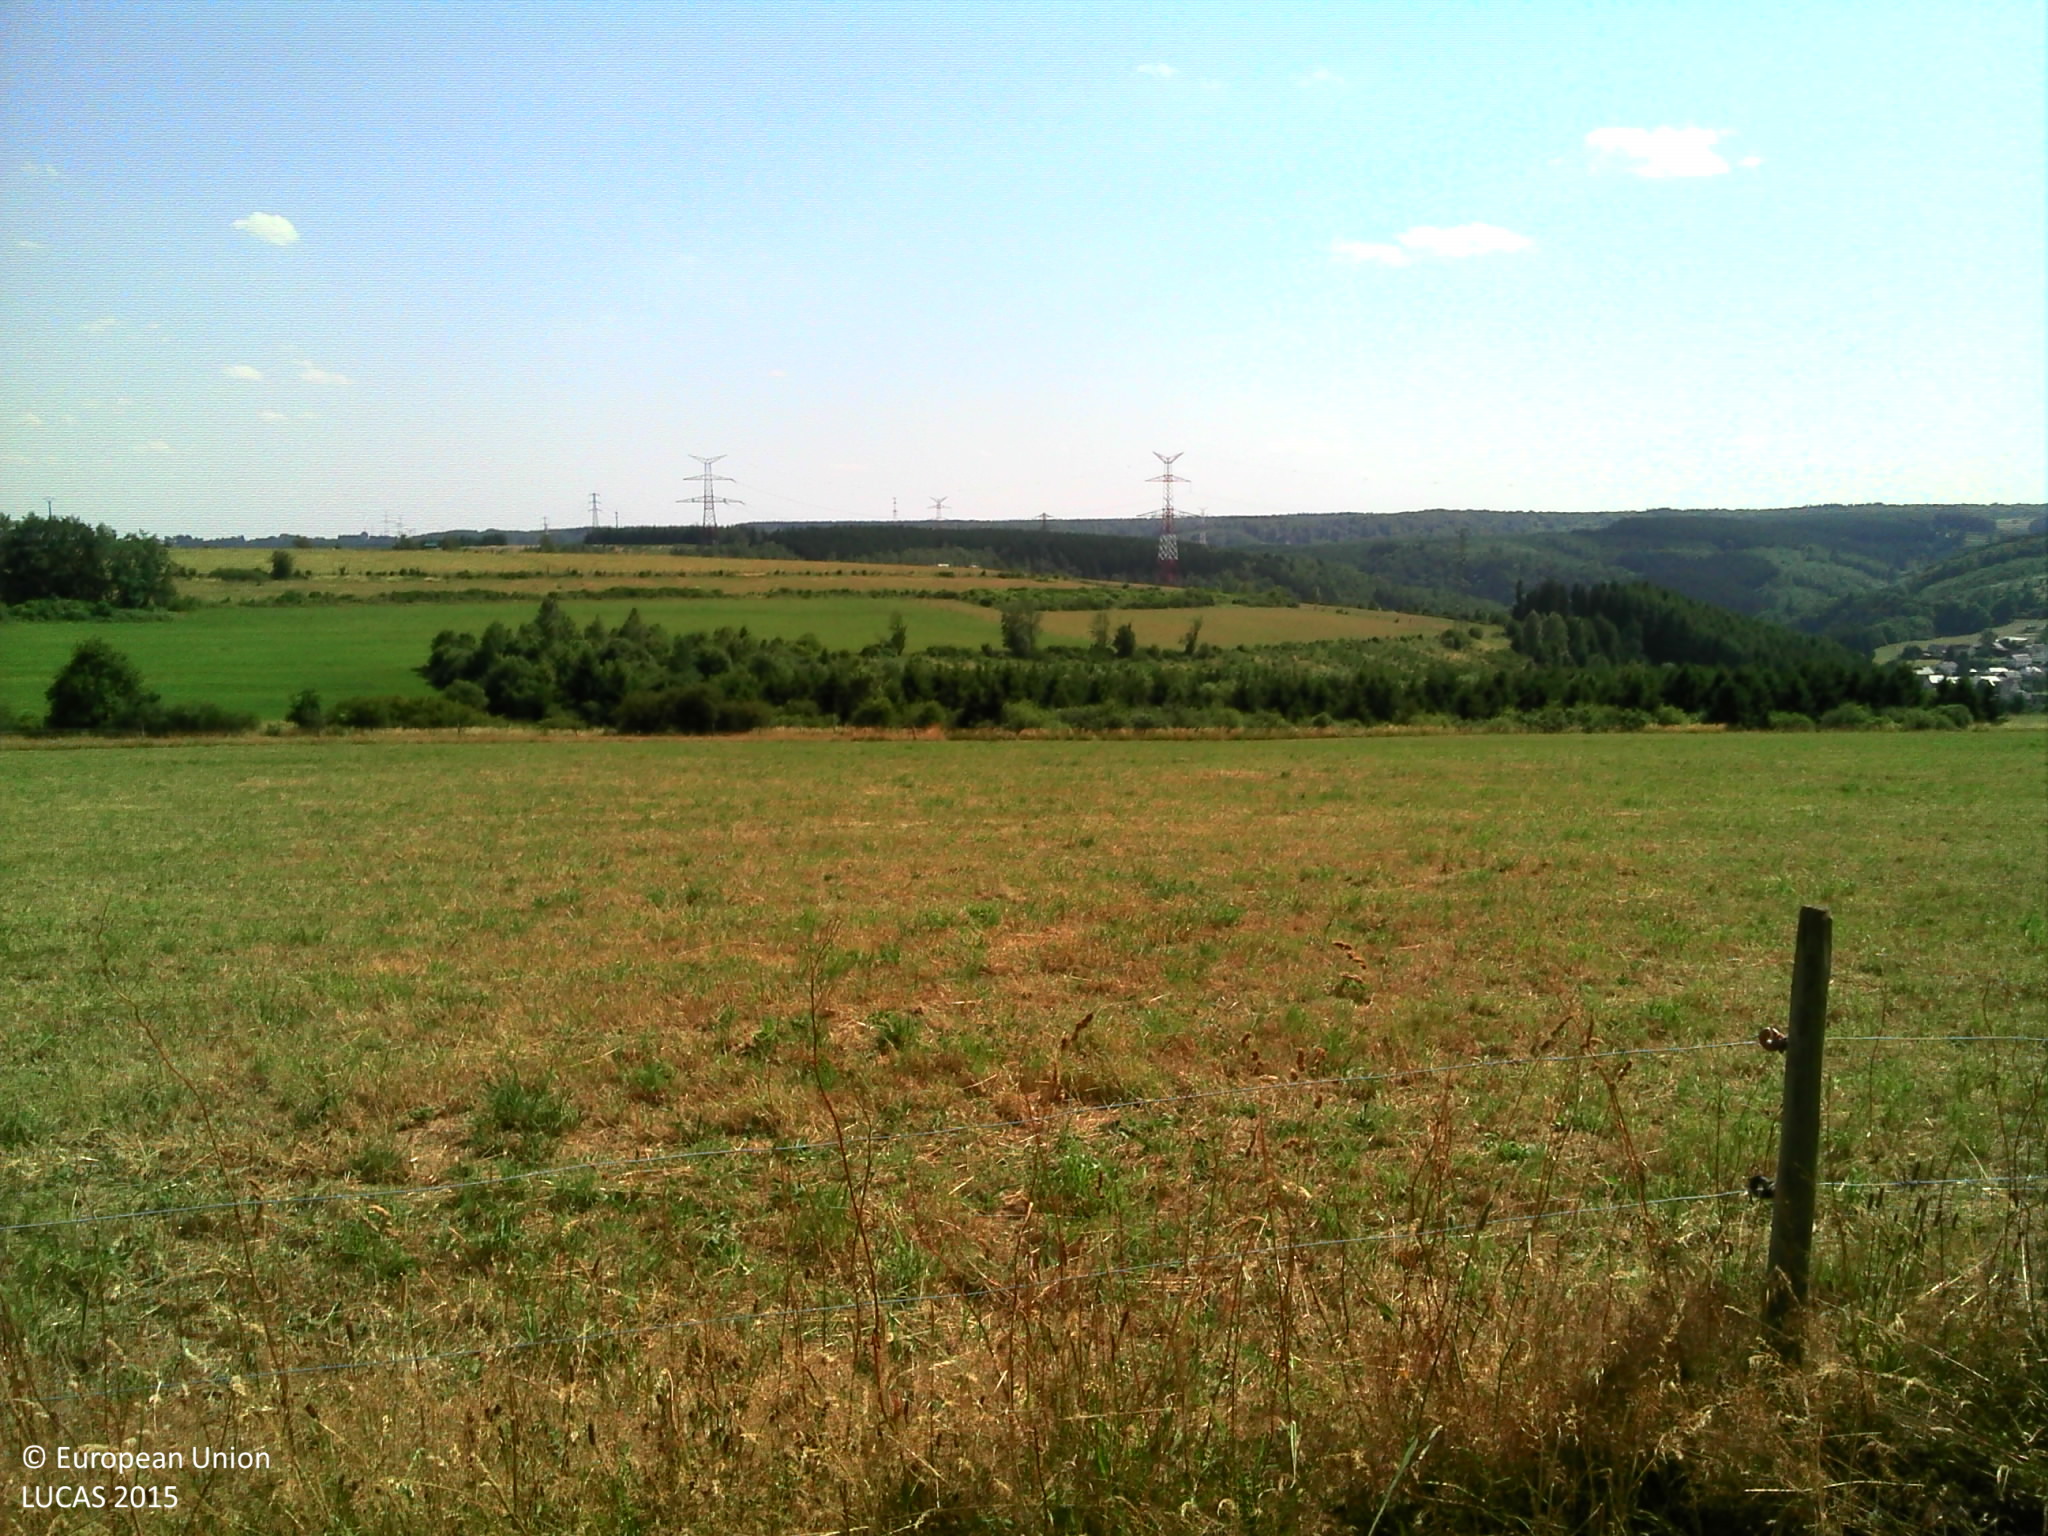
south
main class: Grassland
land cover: Grassland without tree/shrub cover
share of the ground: > 75 %
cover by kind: herbaceous plants 100 %
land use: Agriculture (excluding fallow land and kitchen gardens)
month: July
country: BE
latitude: 49.8522
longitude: 5.7289
